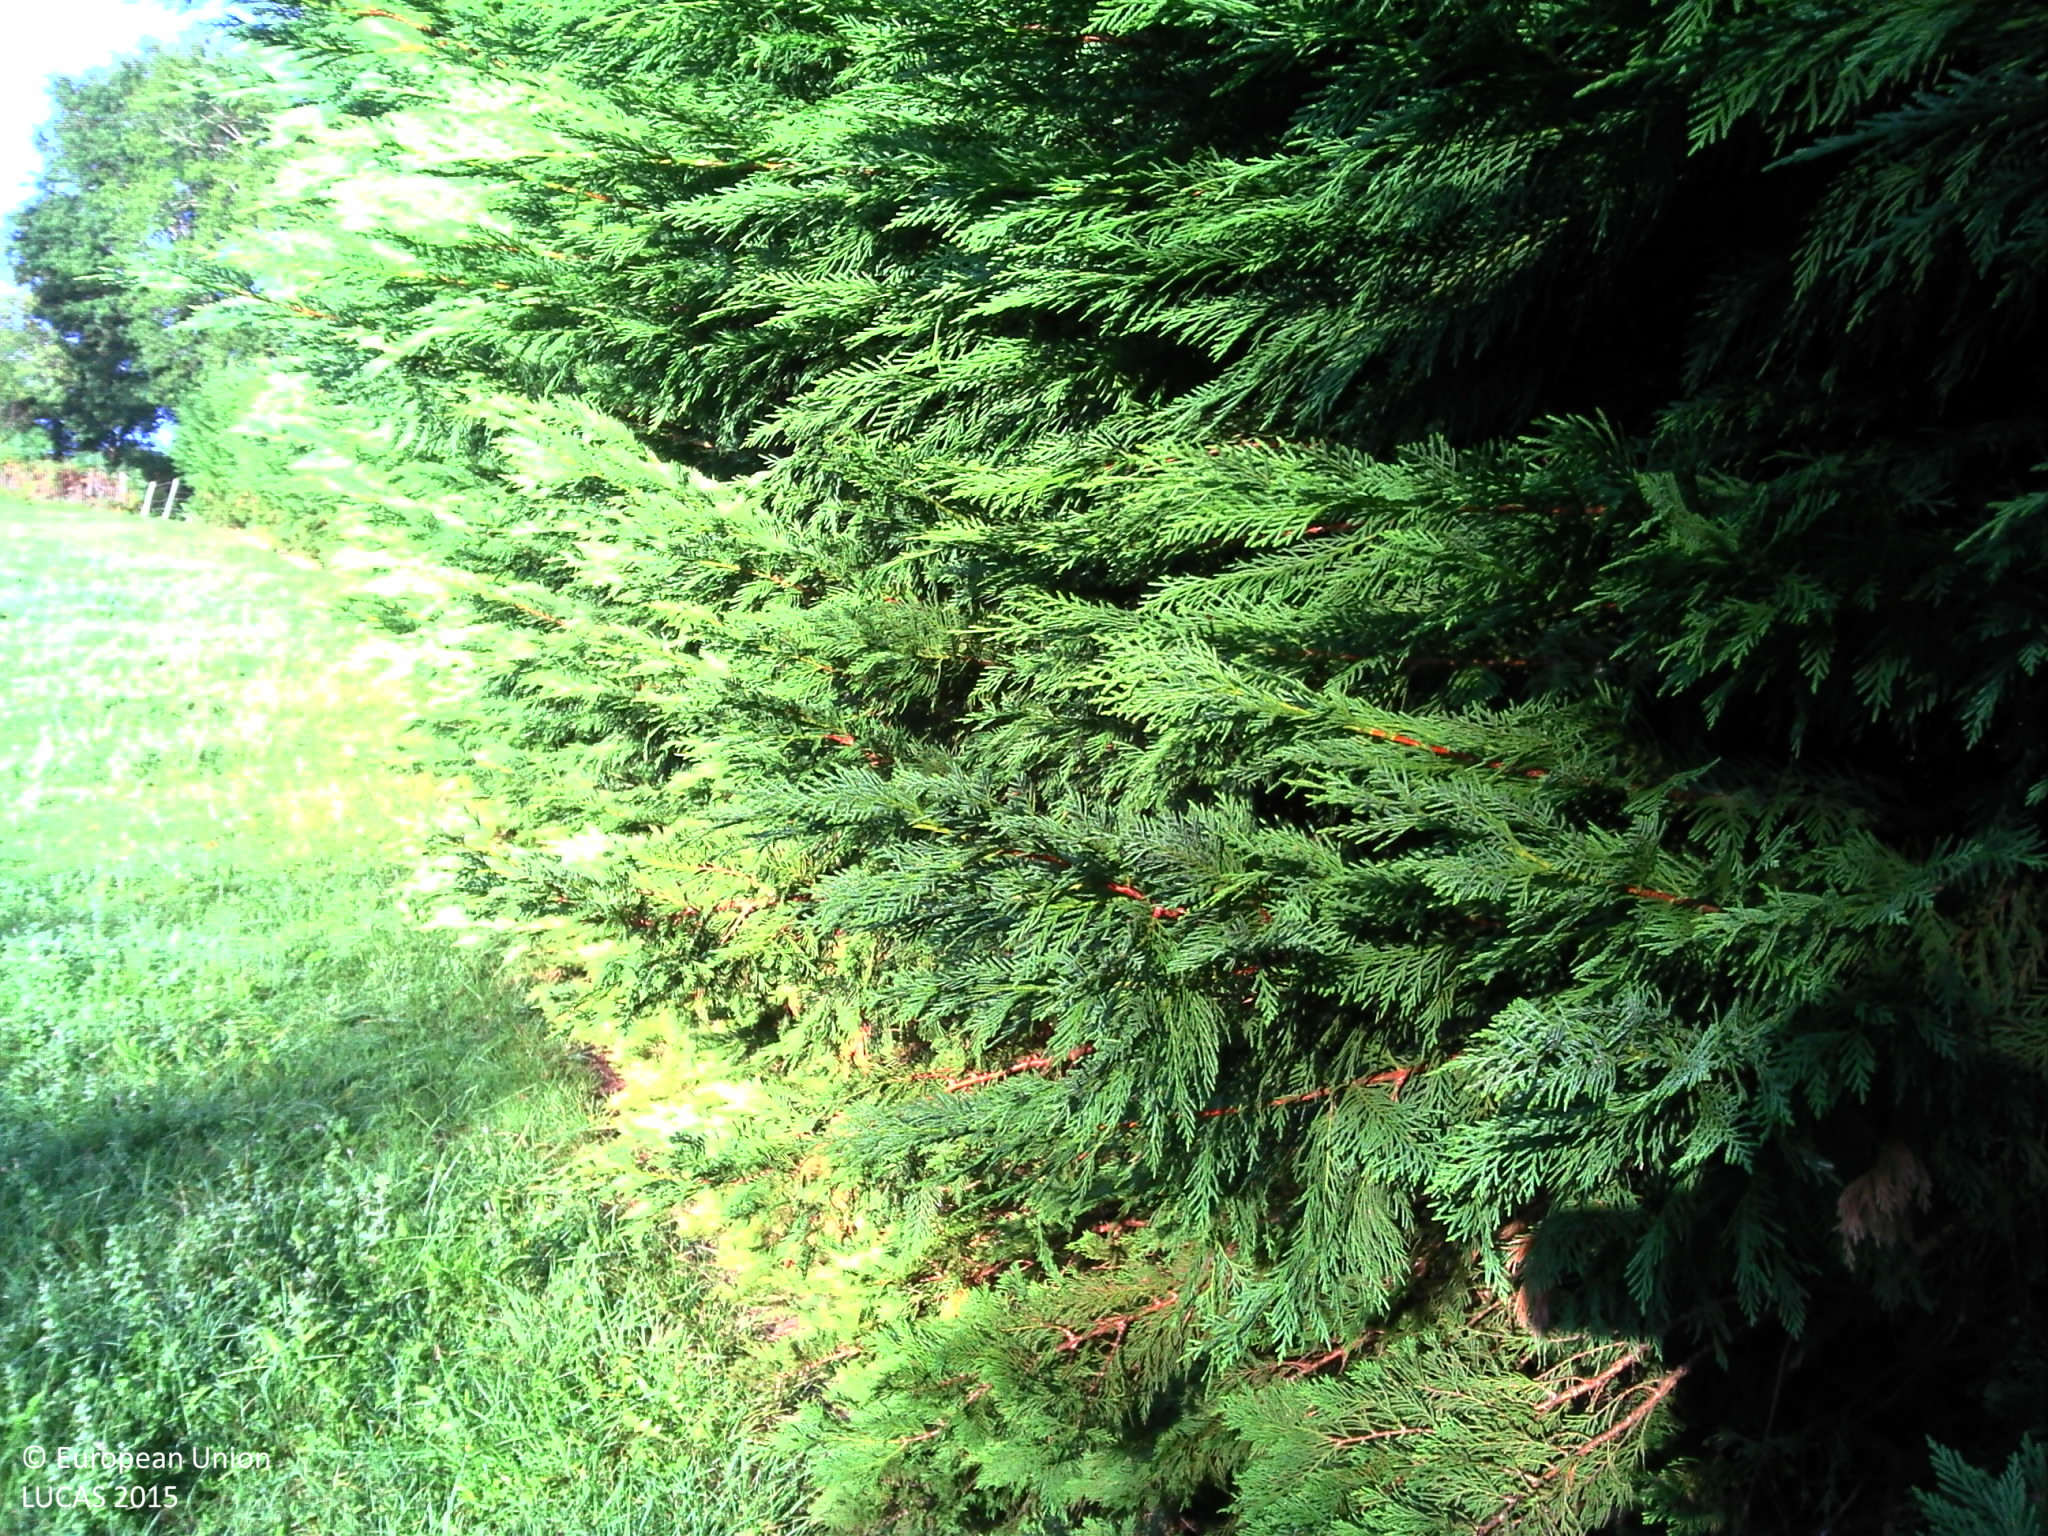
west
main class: Grassland
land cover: Grassland with sparse tree/shrub cover
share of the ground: > 75 %
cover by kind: herbaceous plants 95 %, coniferous forest trees 5 %
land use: Residential
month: September
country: FR
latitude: 43.1285
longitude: -0.2937
